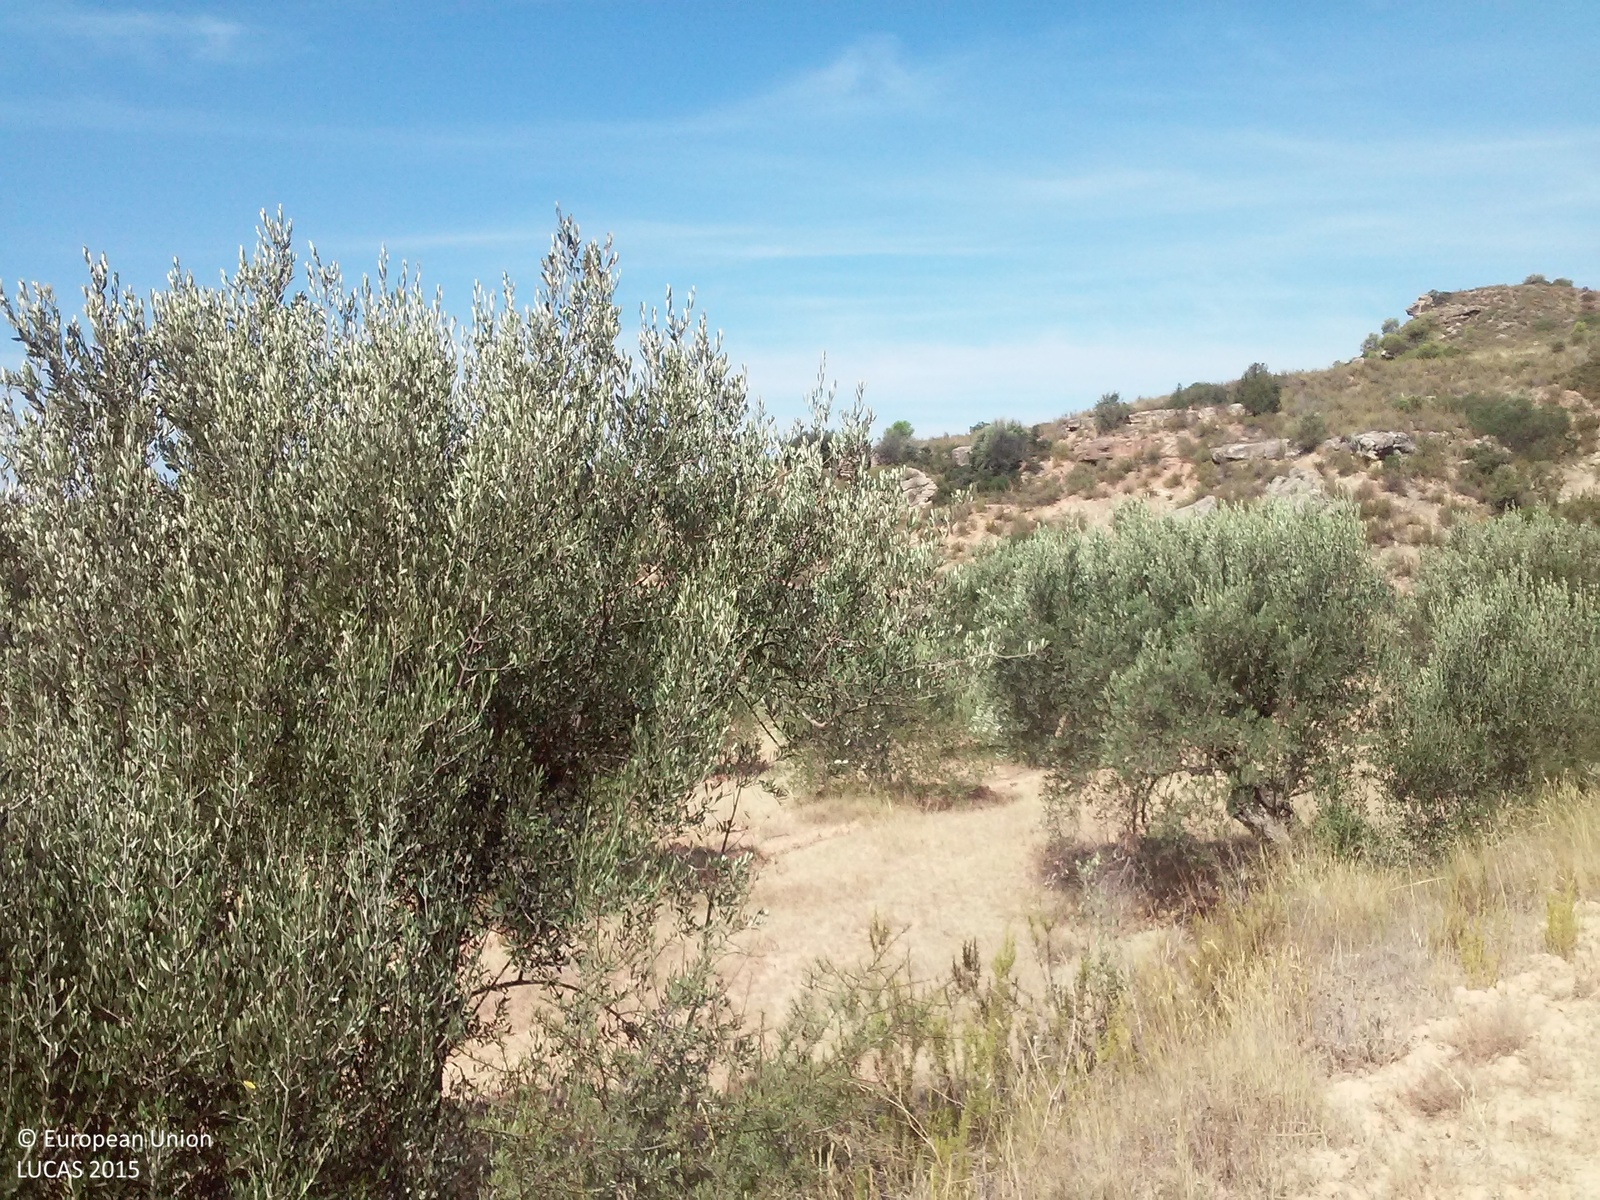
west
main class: Cropland
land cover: Olive groves
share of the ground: 10 - 25 %
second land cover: Spontaneously vegetated surfaces
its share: > 75 %
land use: Agriculture (excluding fallow land and kitchen gardens)
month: August
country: ES
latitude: 41.2613
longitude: 0.5011
